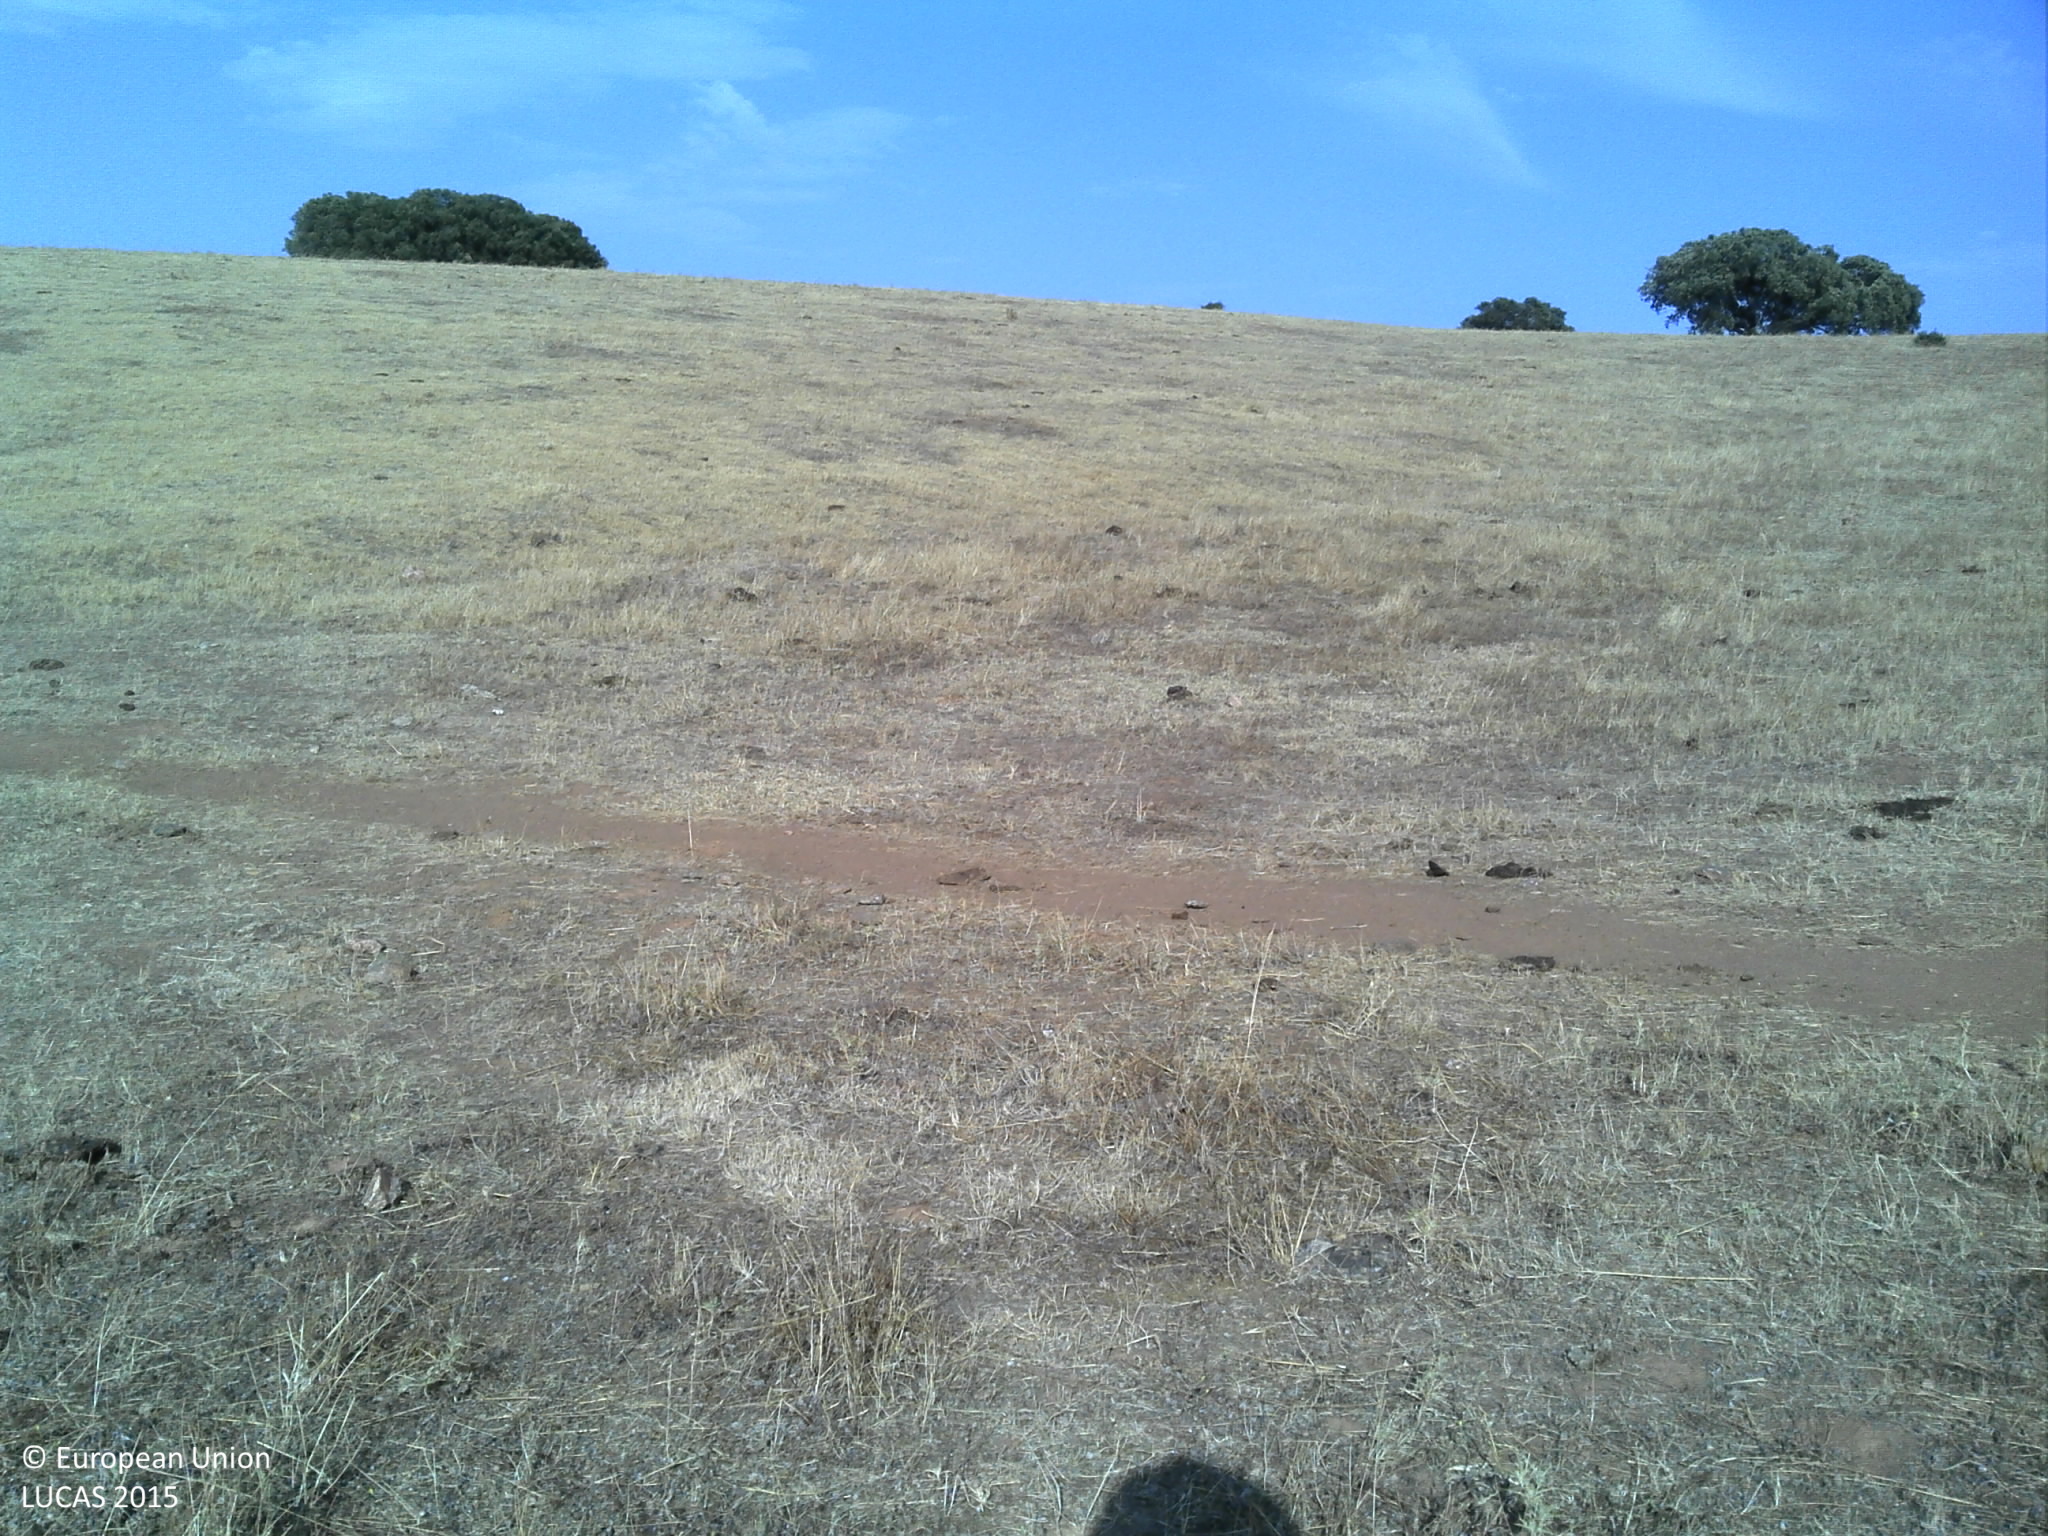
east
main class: Grassland
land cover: Grassland without tree/shrub cover
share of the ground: 10 - 25 %
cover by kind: unconsolidated bare surface 85 %, herbaceous plants 15 %
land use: Agriculture (excluding fallow land and kitchen gardens)
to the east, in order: Grassland without tree/shrub cover; Tracks; Grassland without tree/shrub cover; Fences; Grassland without tree/shrub cover
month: July
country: PT
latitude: 37.8292
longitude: -7.8036
